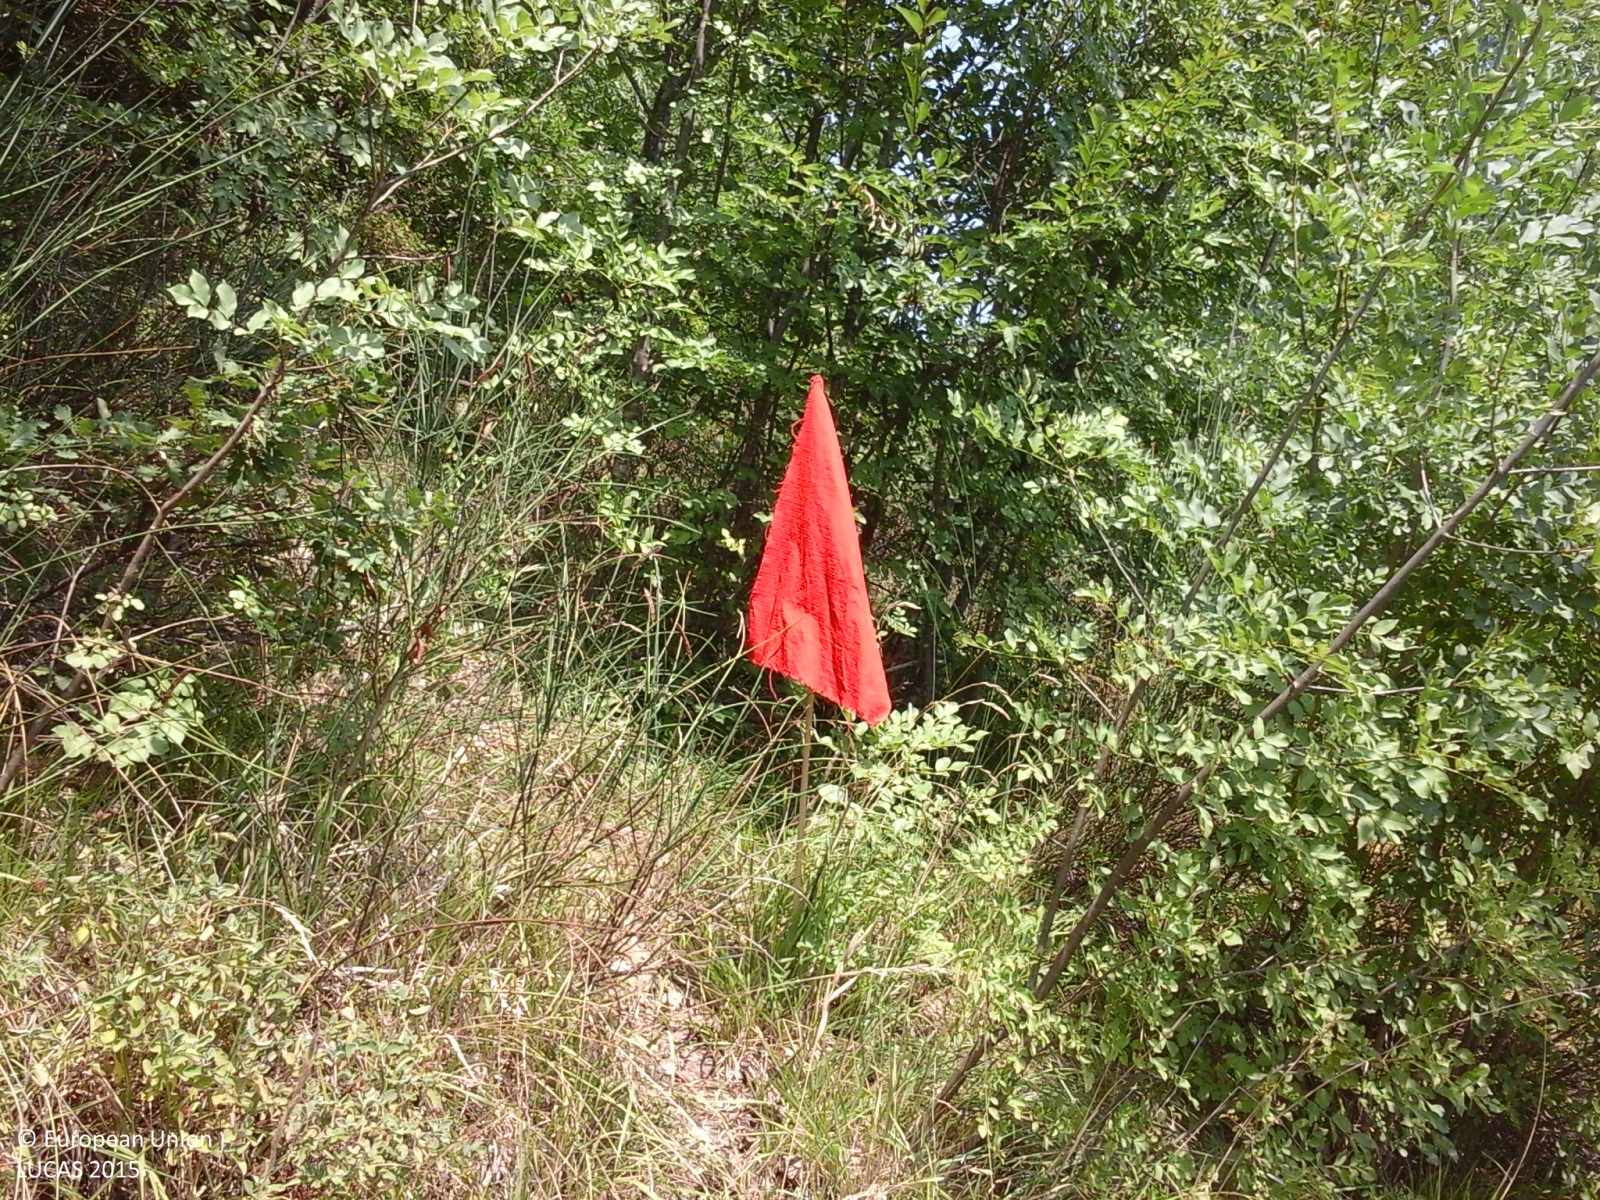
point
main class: Woodland
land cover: Broadleaved woodland
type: mesophytic deciduous forest
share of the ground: > 75 %
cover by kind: broadleaved forest trees 100 %
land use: Forestry
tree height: > 5 m
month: August
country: IT
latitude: 43.0757
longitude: 13.1232
